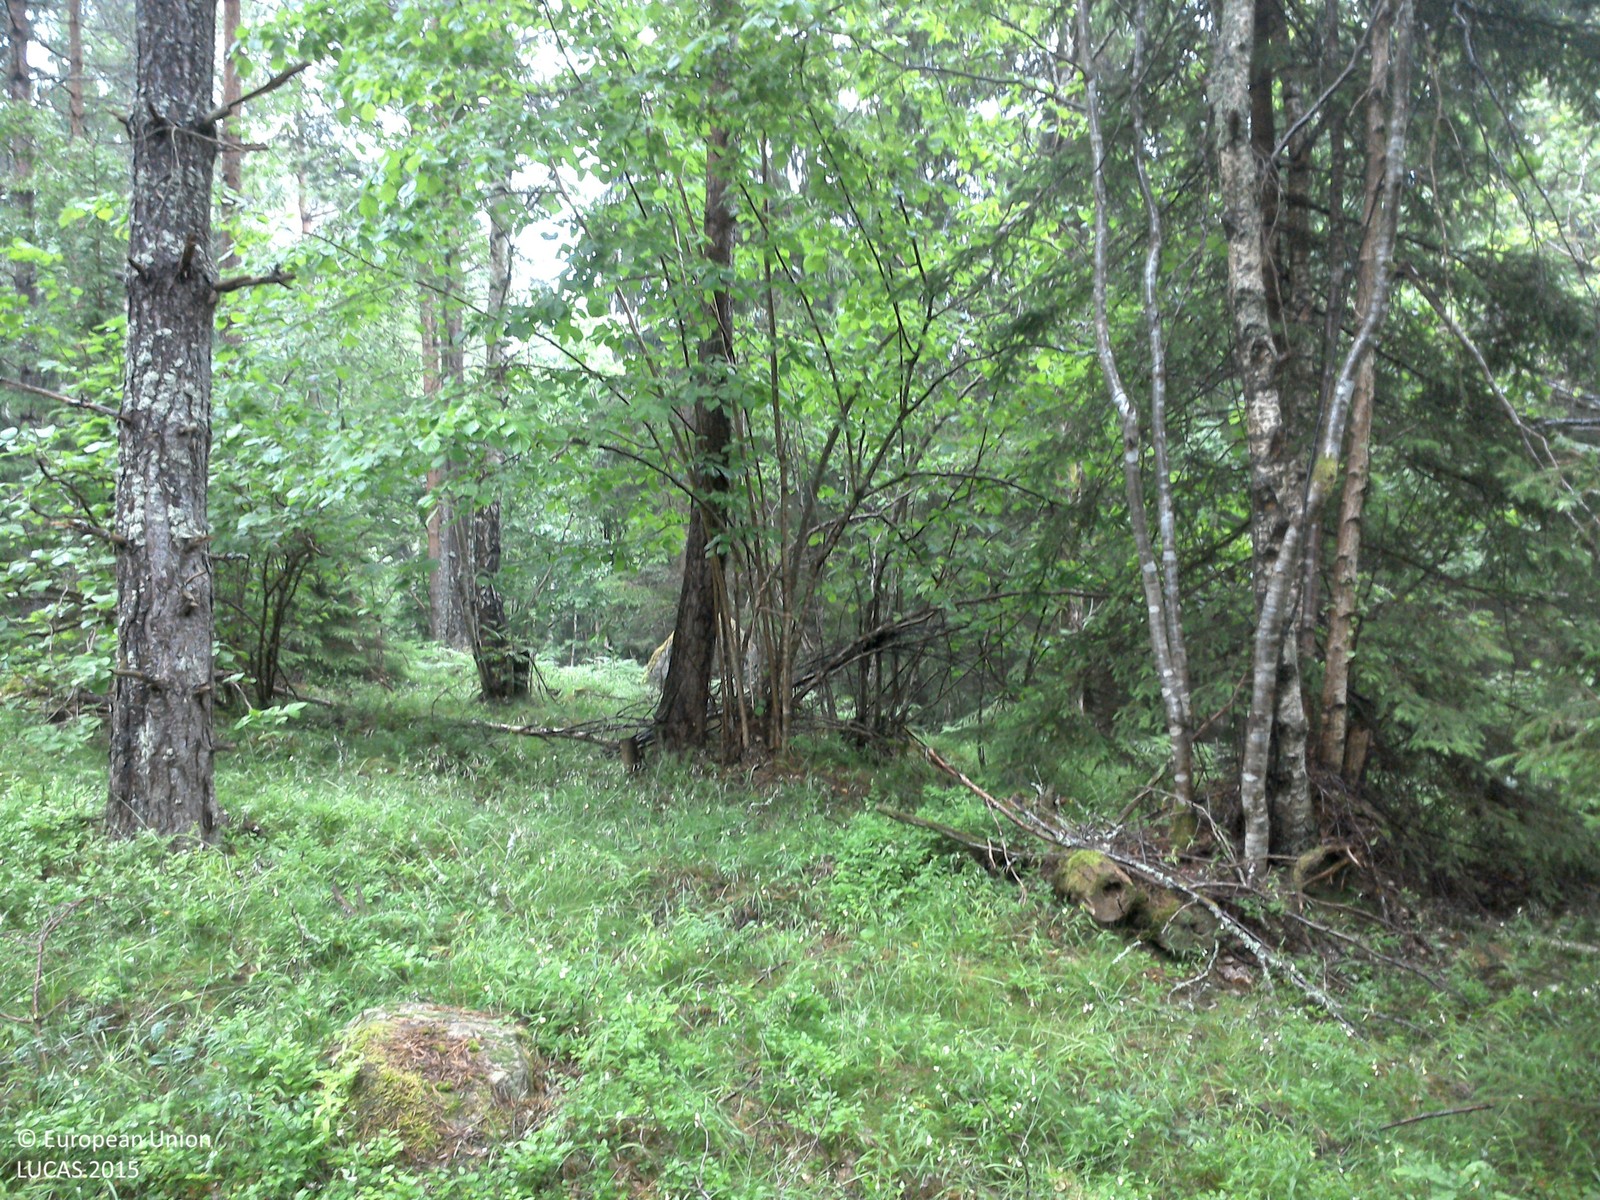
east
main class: Woodland
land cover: Pine dominated coniferous woodland
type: boreal forest
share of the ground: > 75 %
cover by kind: coniferous forest trees 75 %, herbaceous plants 20 %, lichens and mosses 5 %
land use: Forestry
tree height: > 5 m
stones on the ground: < 10 %
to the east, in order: Pine dominated coniferous woodland; Spruce dominated coniferous woodland; Spruce dominated mixed woodland; Spruce dominated coniferous woodland; Spruce dominated mixed woodland
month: July
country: SE
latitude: 58.5940
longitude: 15.0346
